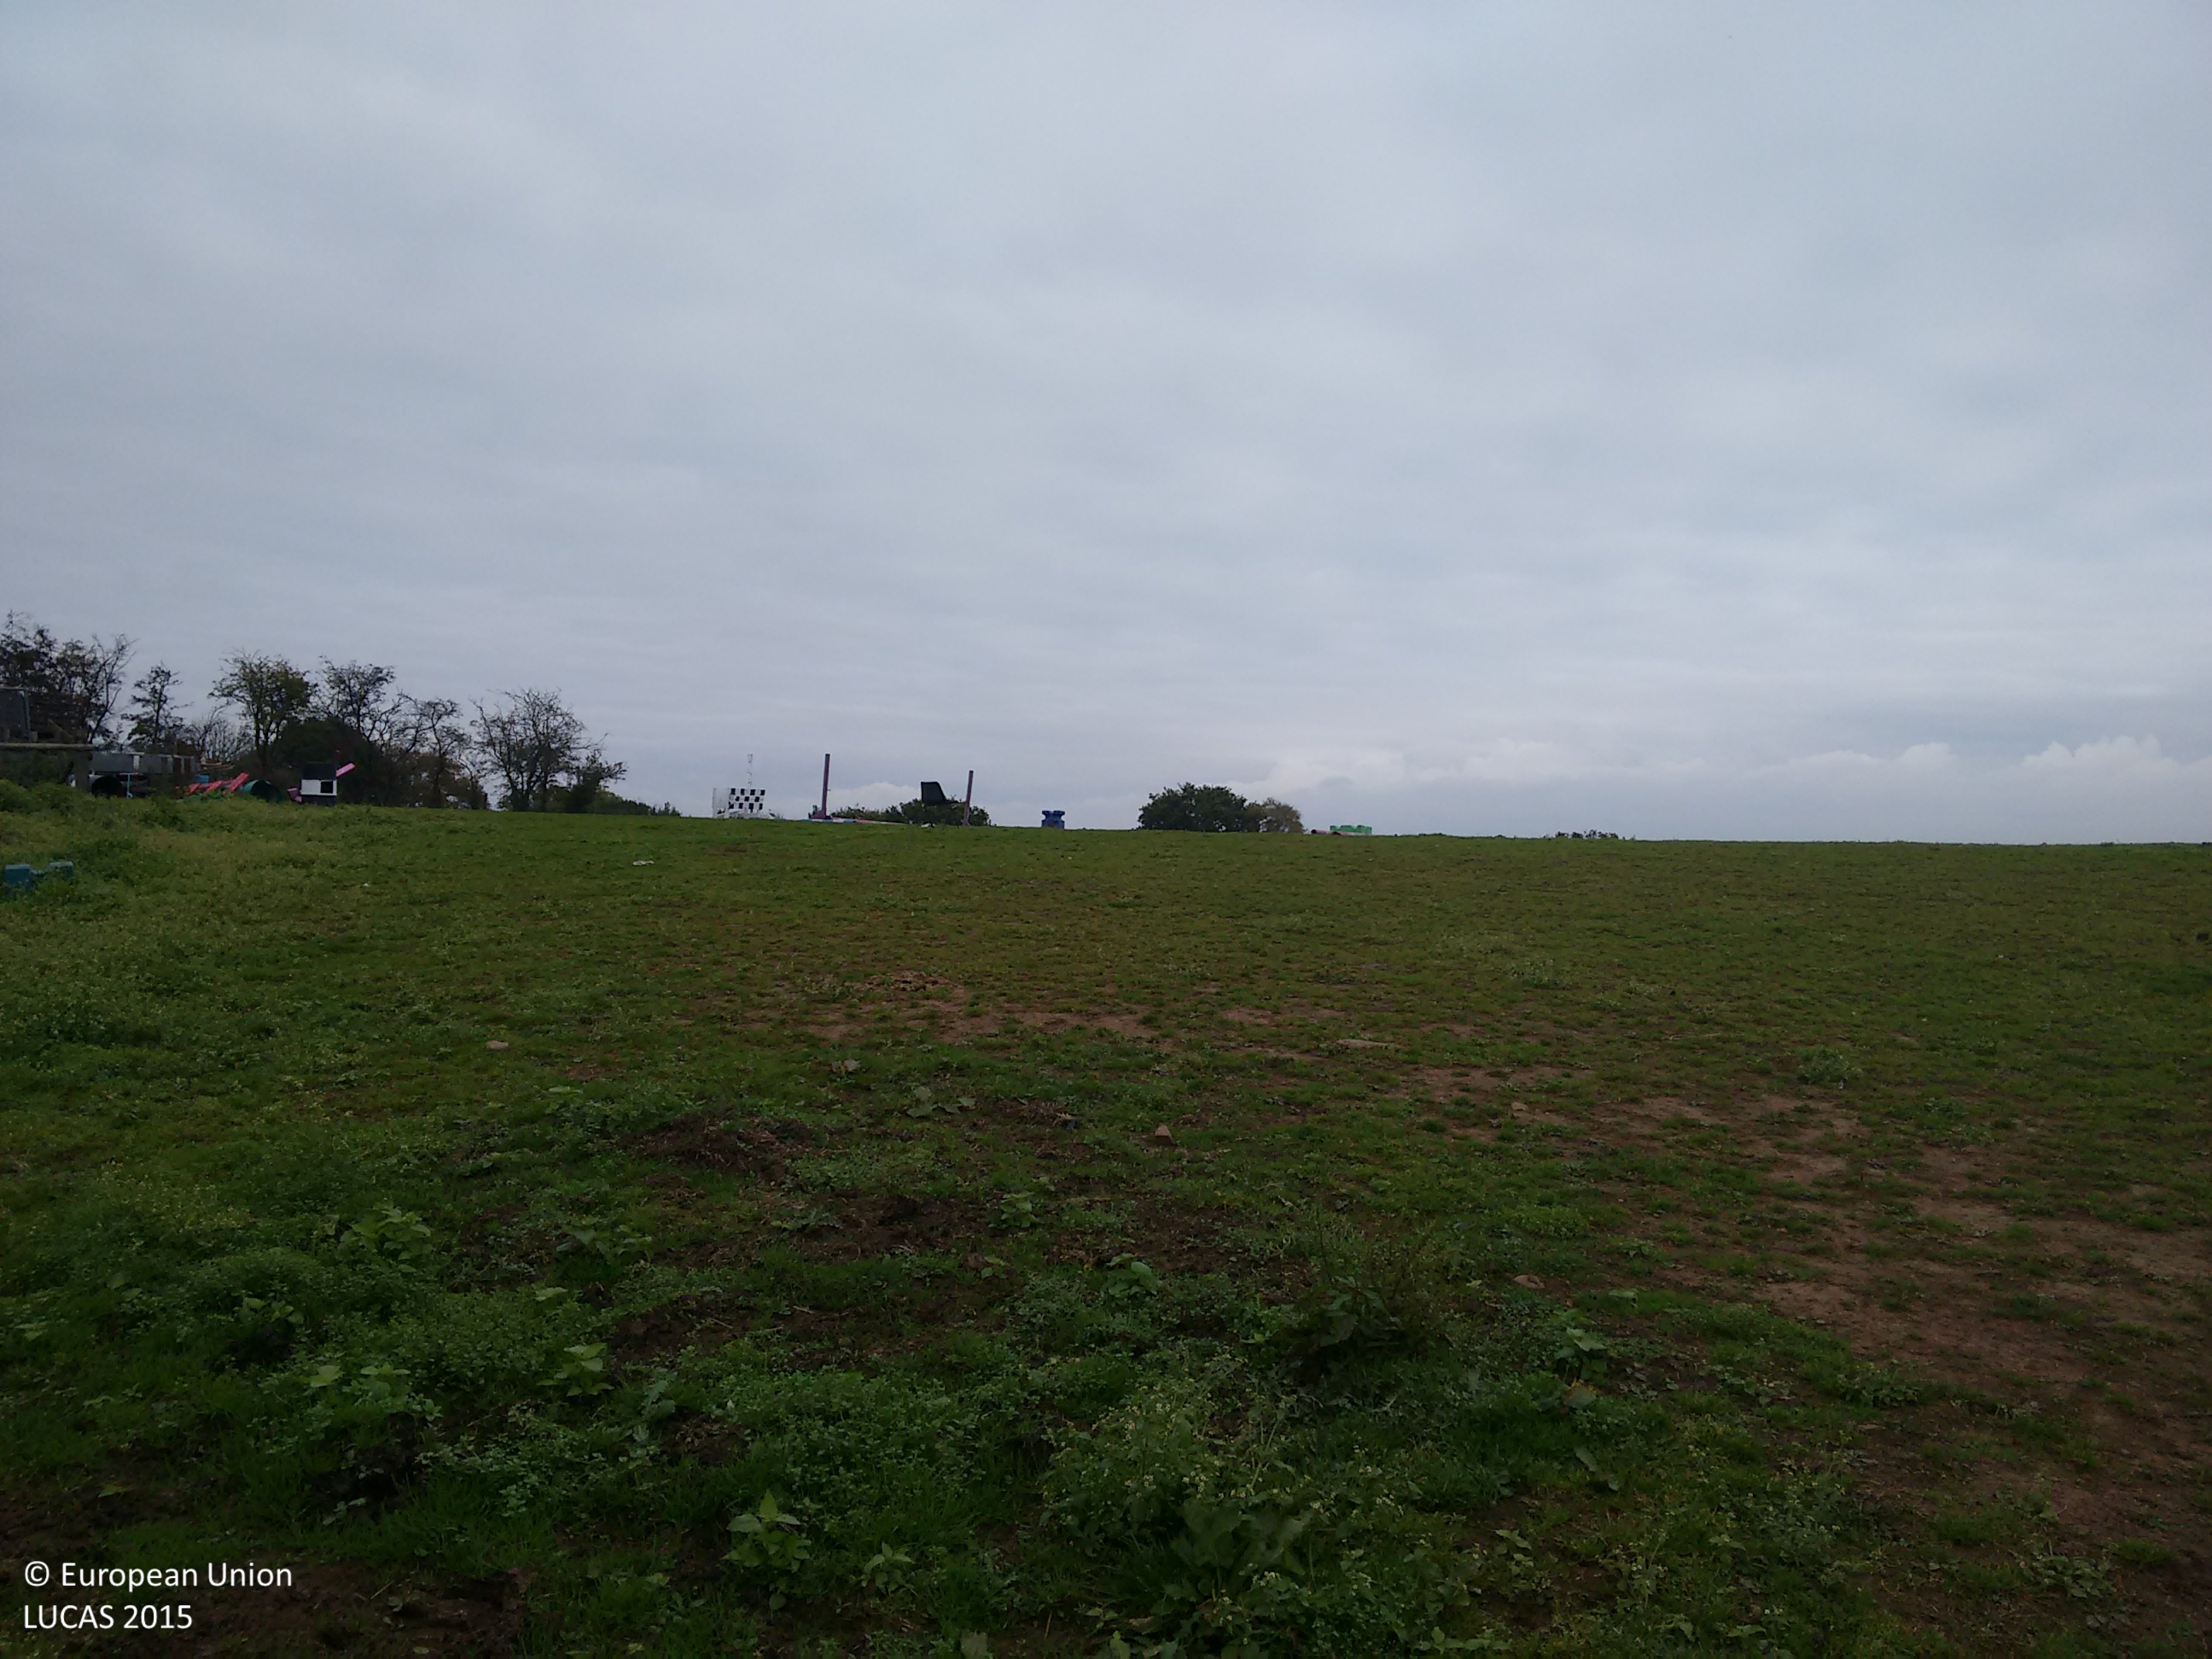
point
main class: Grassland
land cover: Grassland without tree/shrub cover
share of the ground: > 75 %
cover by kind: herbaceous plants 100 %
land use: Agriculture (excluding fallow land and kitchen gardens)
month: October
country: GB
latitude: 51.7489
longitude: -2.5090
